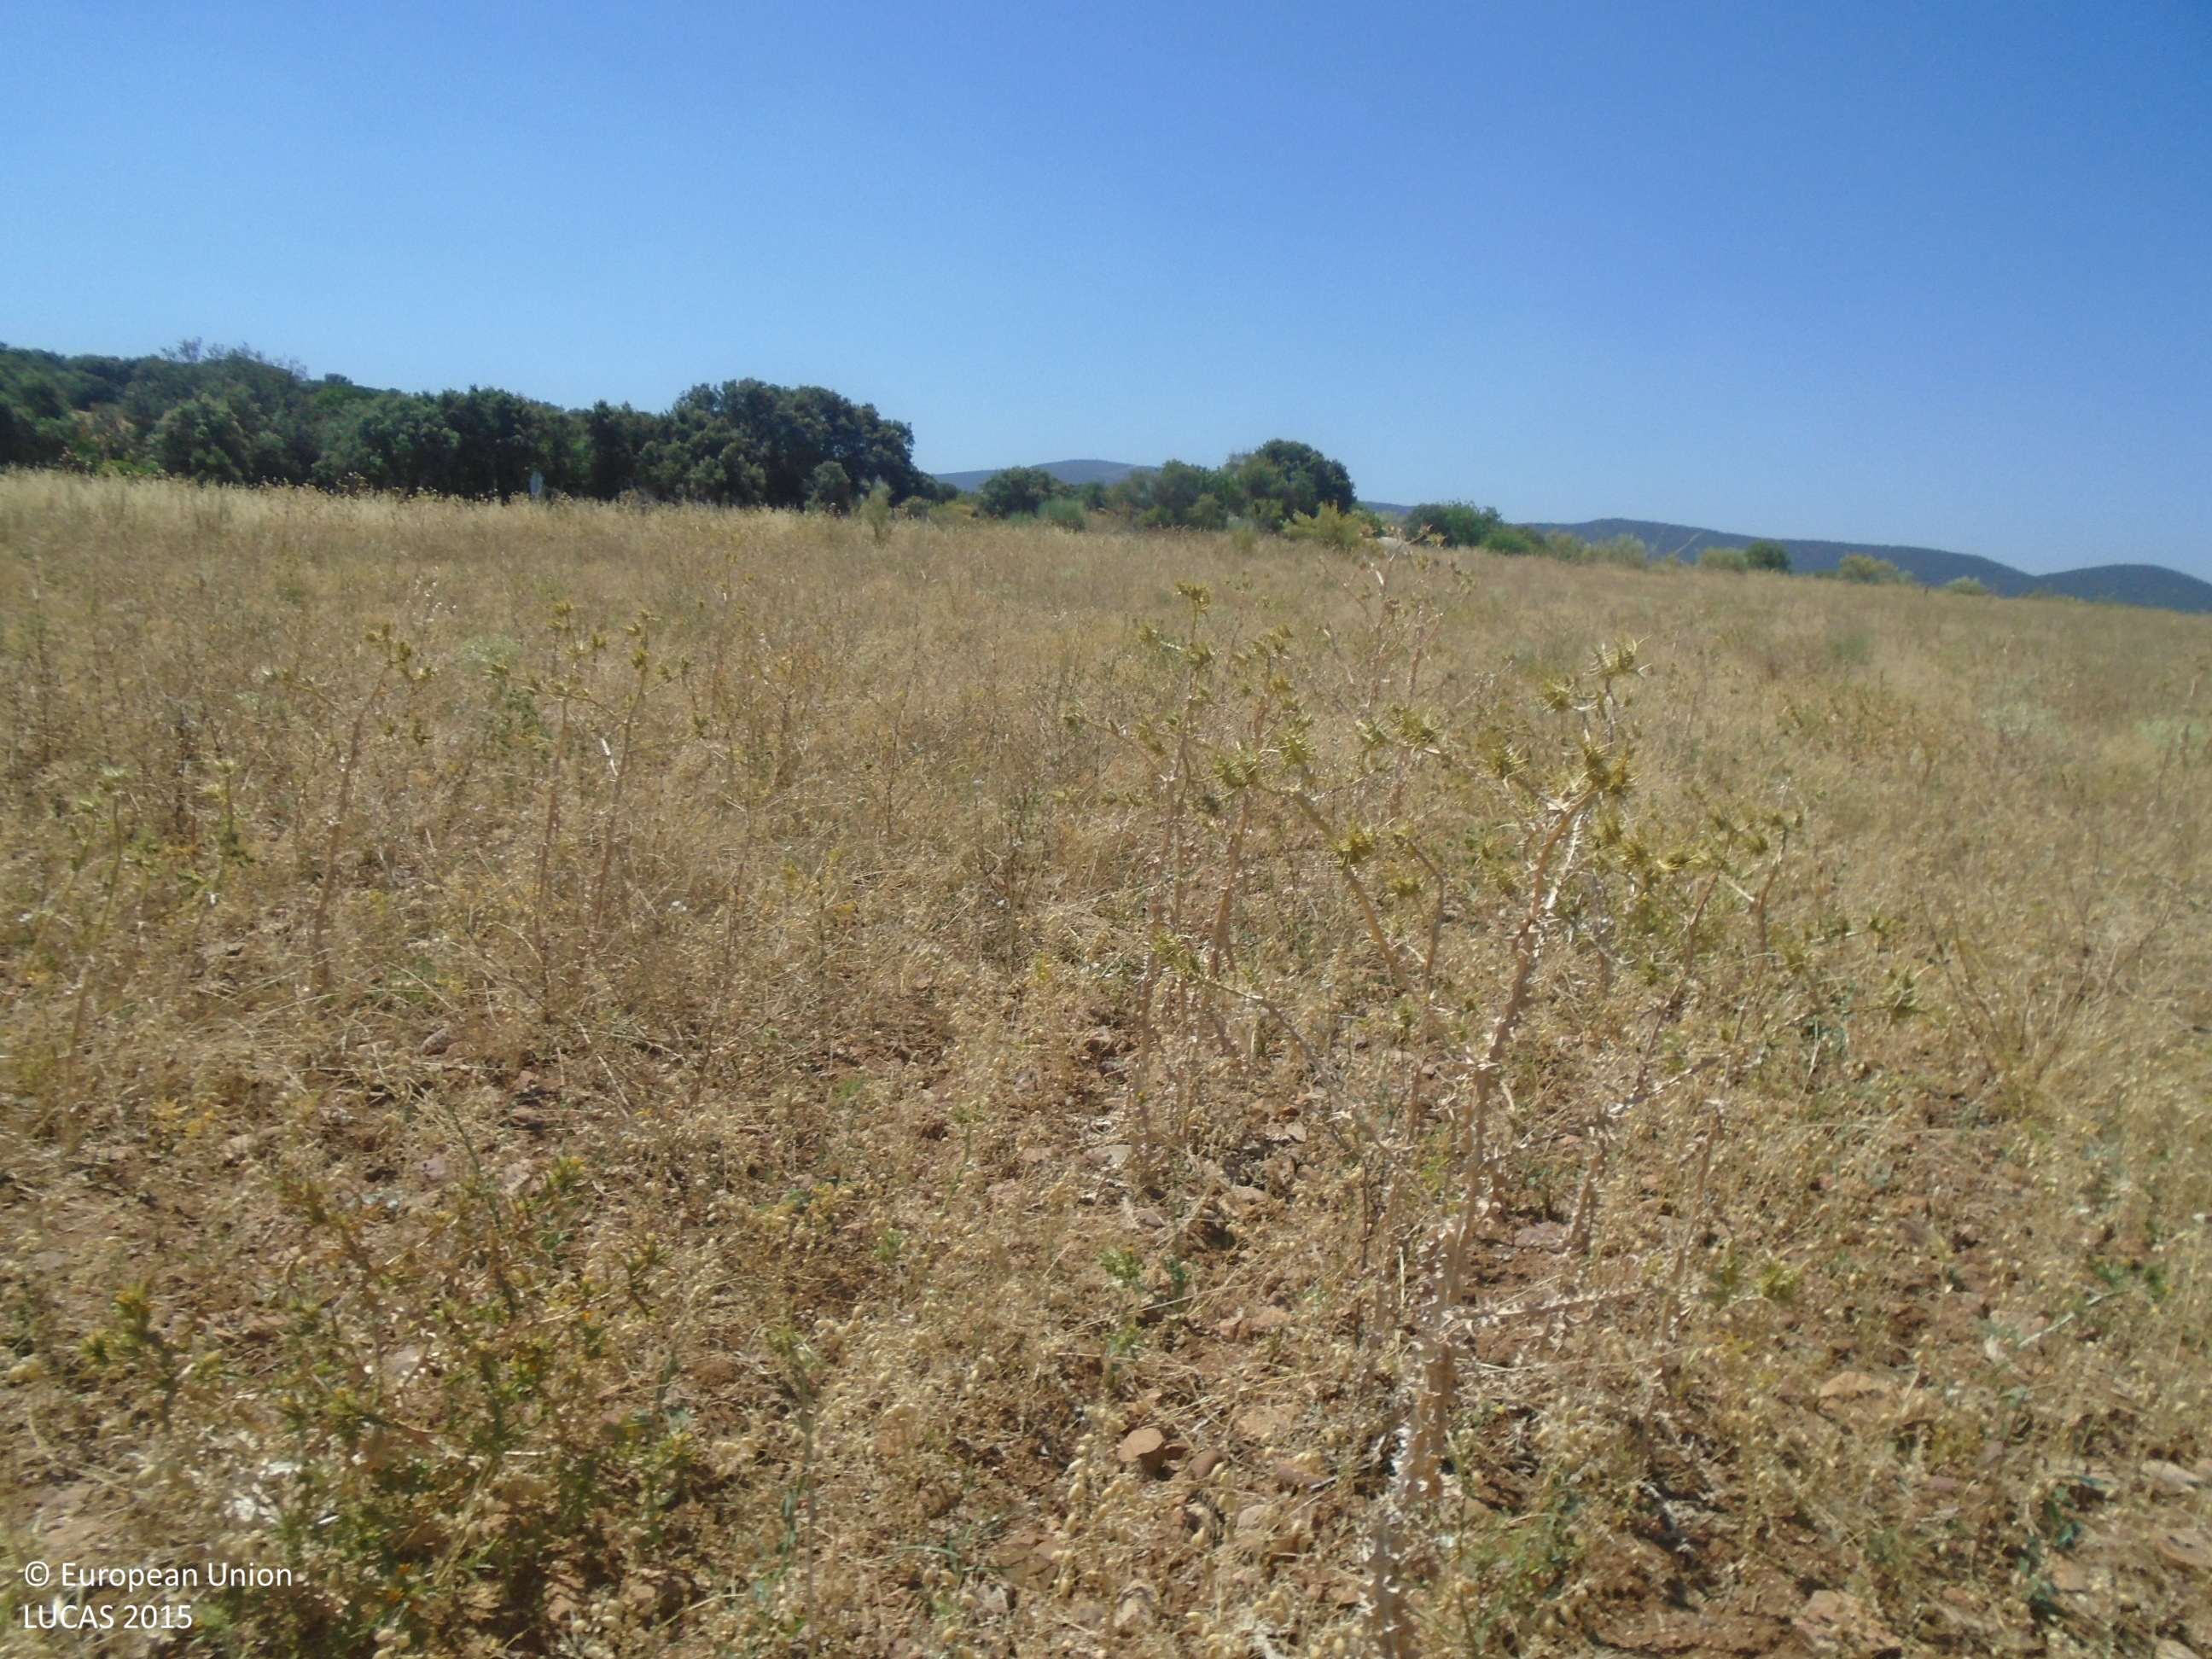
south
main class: Grassland
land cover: Spontaneously vegetated surfaces
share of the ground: > 75 %
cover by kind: herbaceous plants 100 %
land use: Fallow land
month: July
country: ES
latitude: 39.7711
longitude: -5.0976
